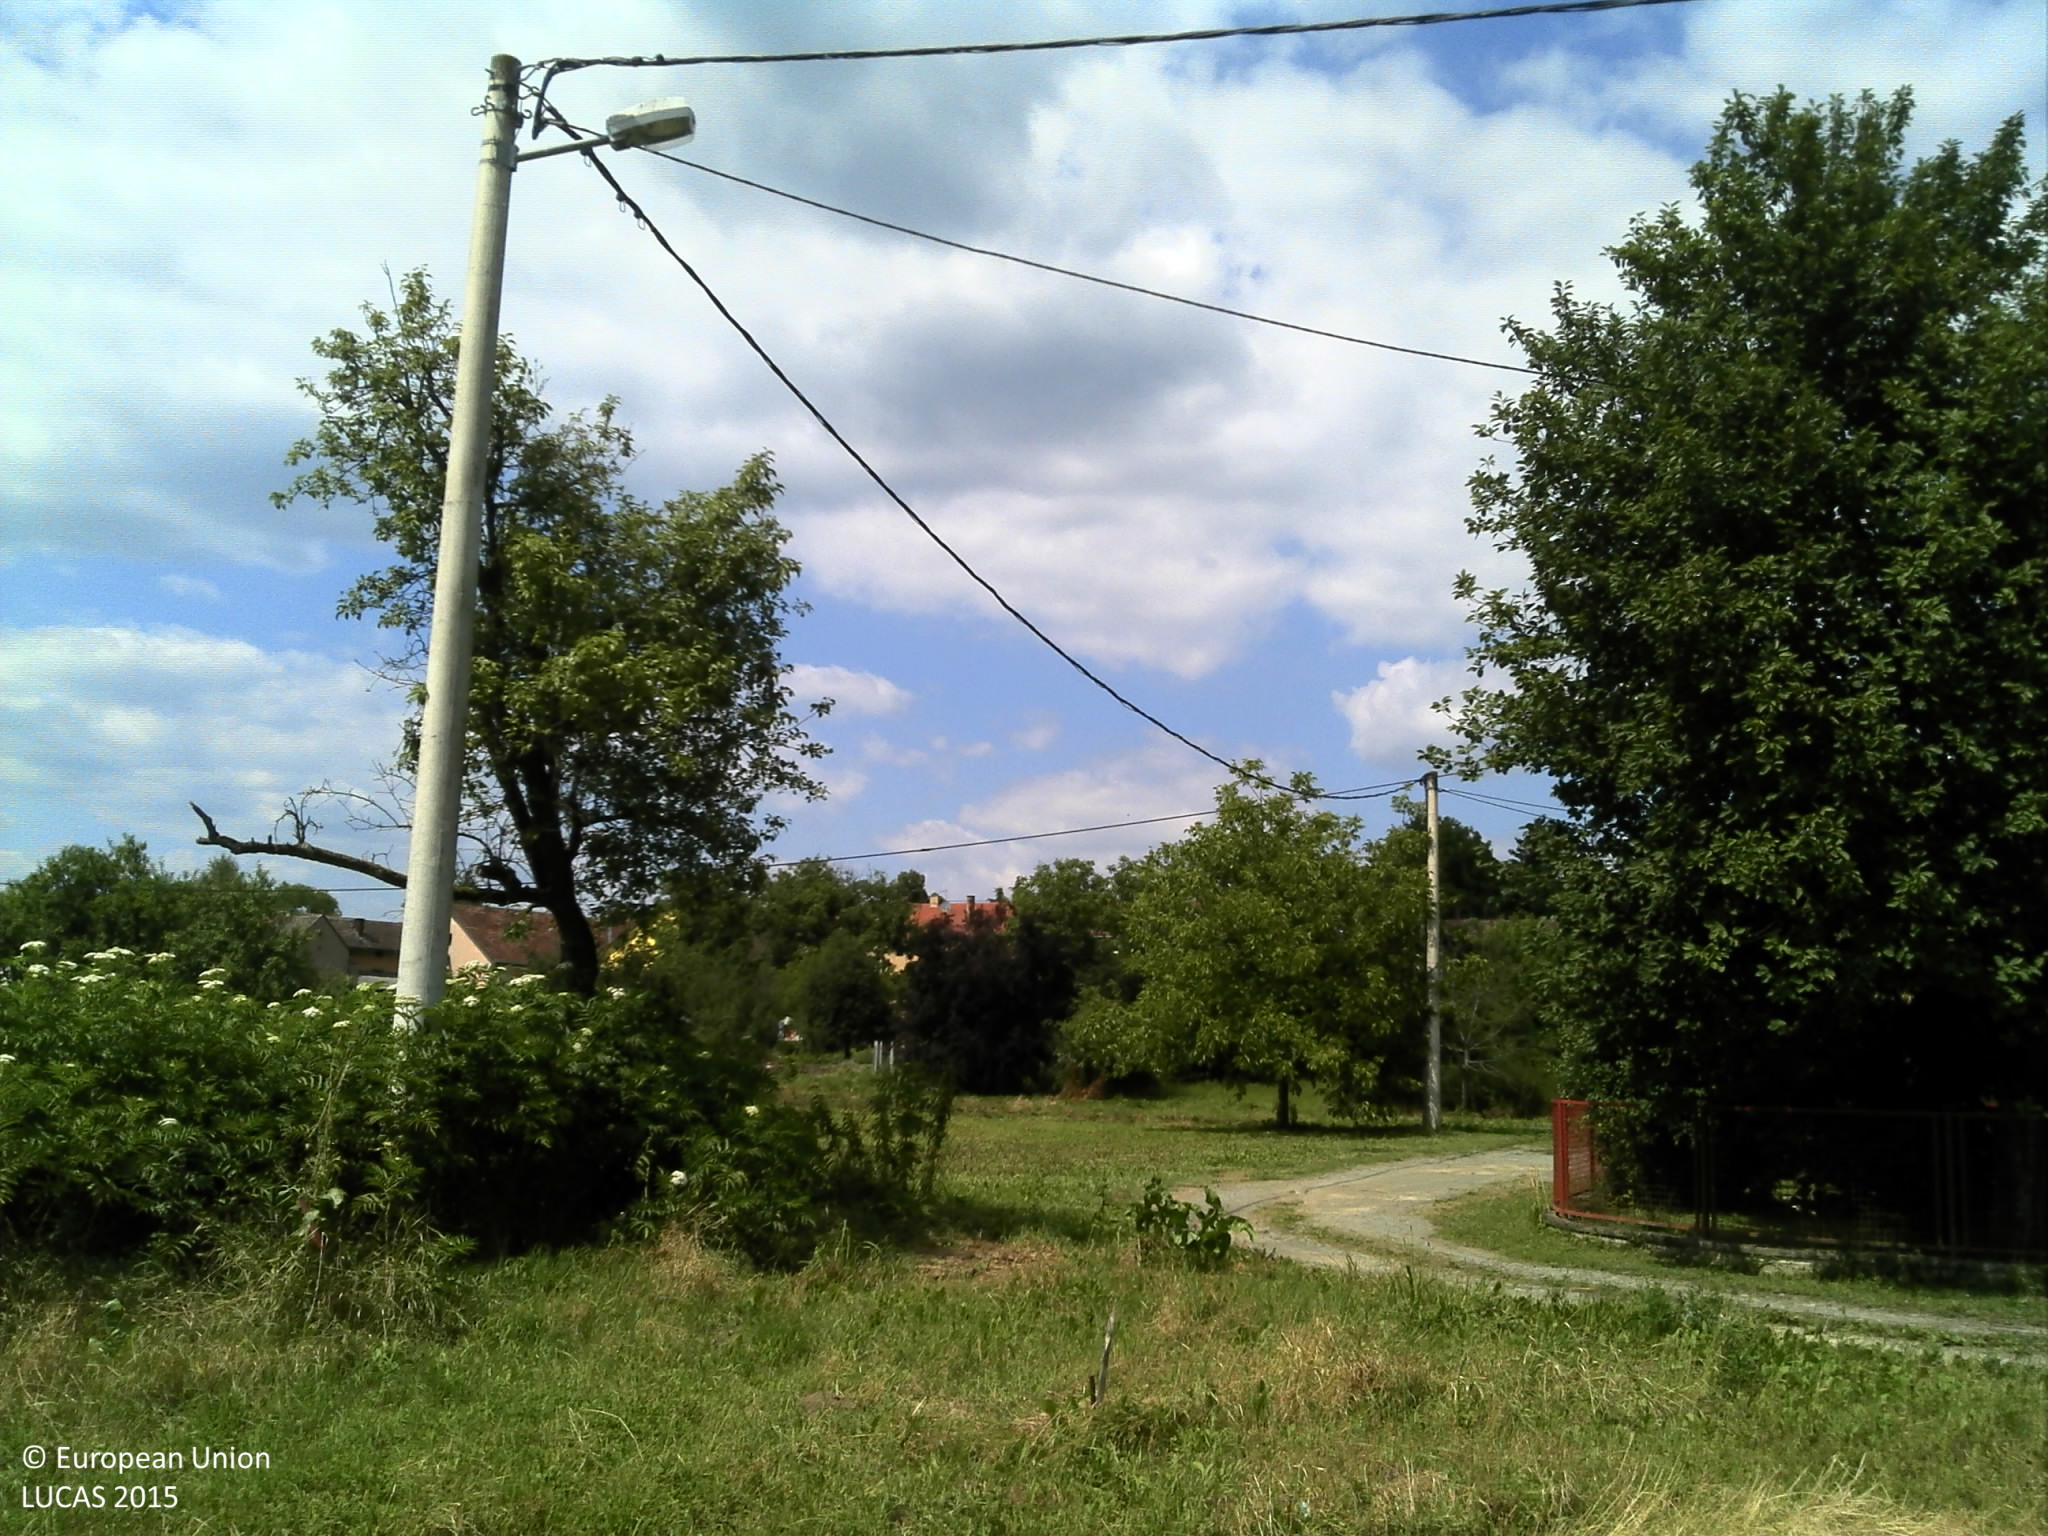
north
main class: Grassland
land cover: Grassland without tree/shrub cover
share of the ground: > 75 %
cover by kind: herbaceous plants 100 %
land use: Agriculture (excluding fallow land and kitchen gardens)
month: June
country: HR
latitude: 45.2585
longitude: 17.1994
